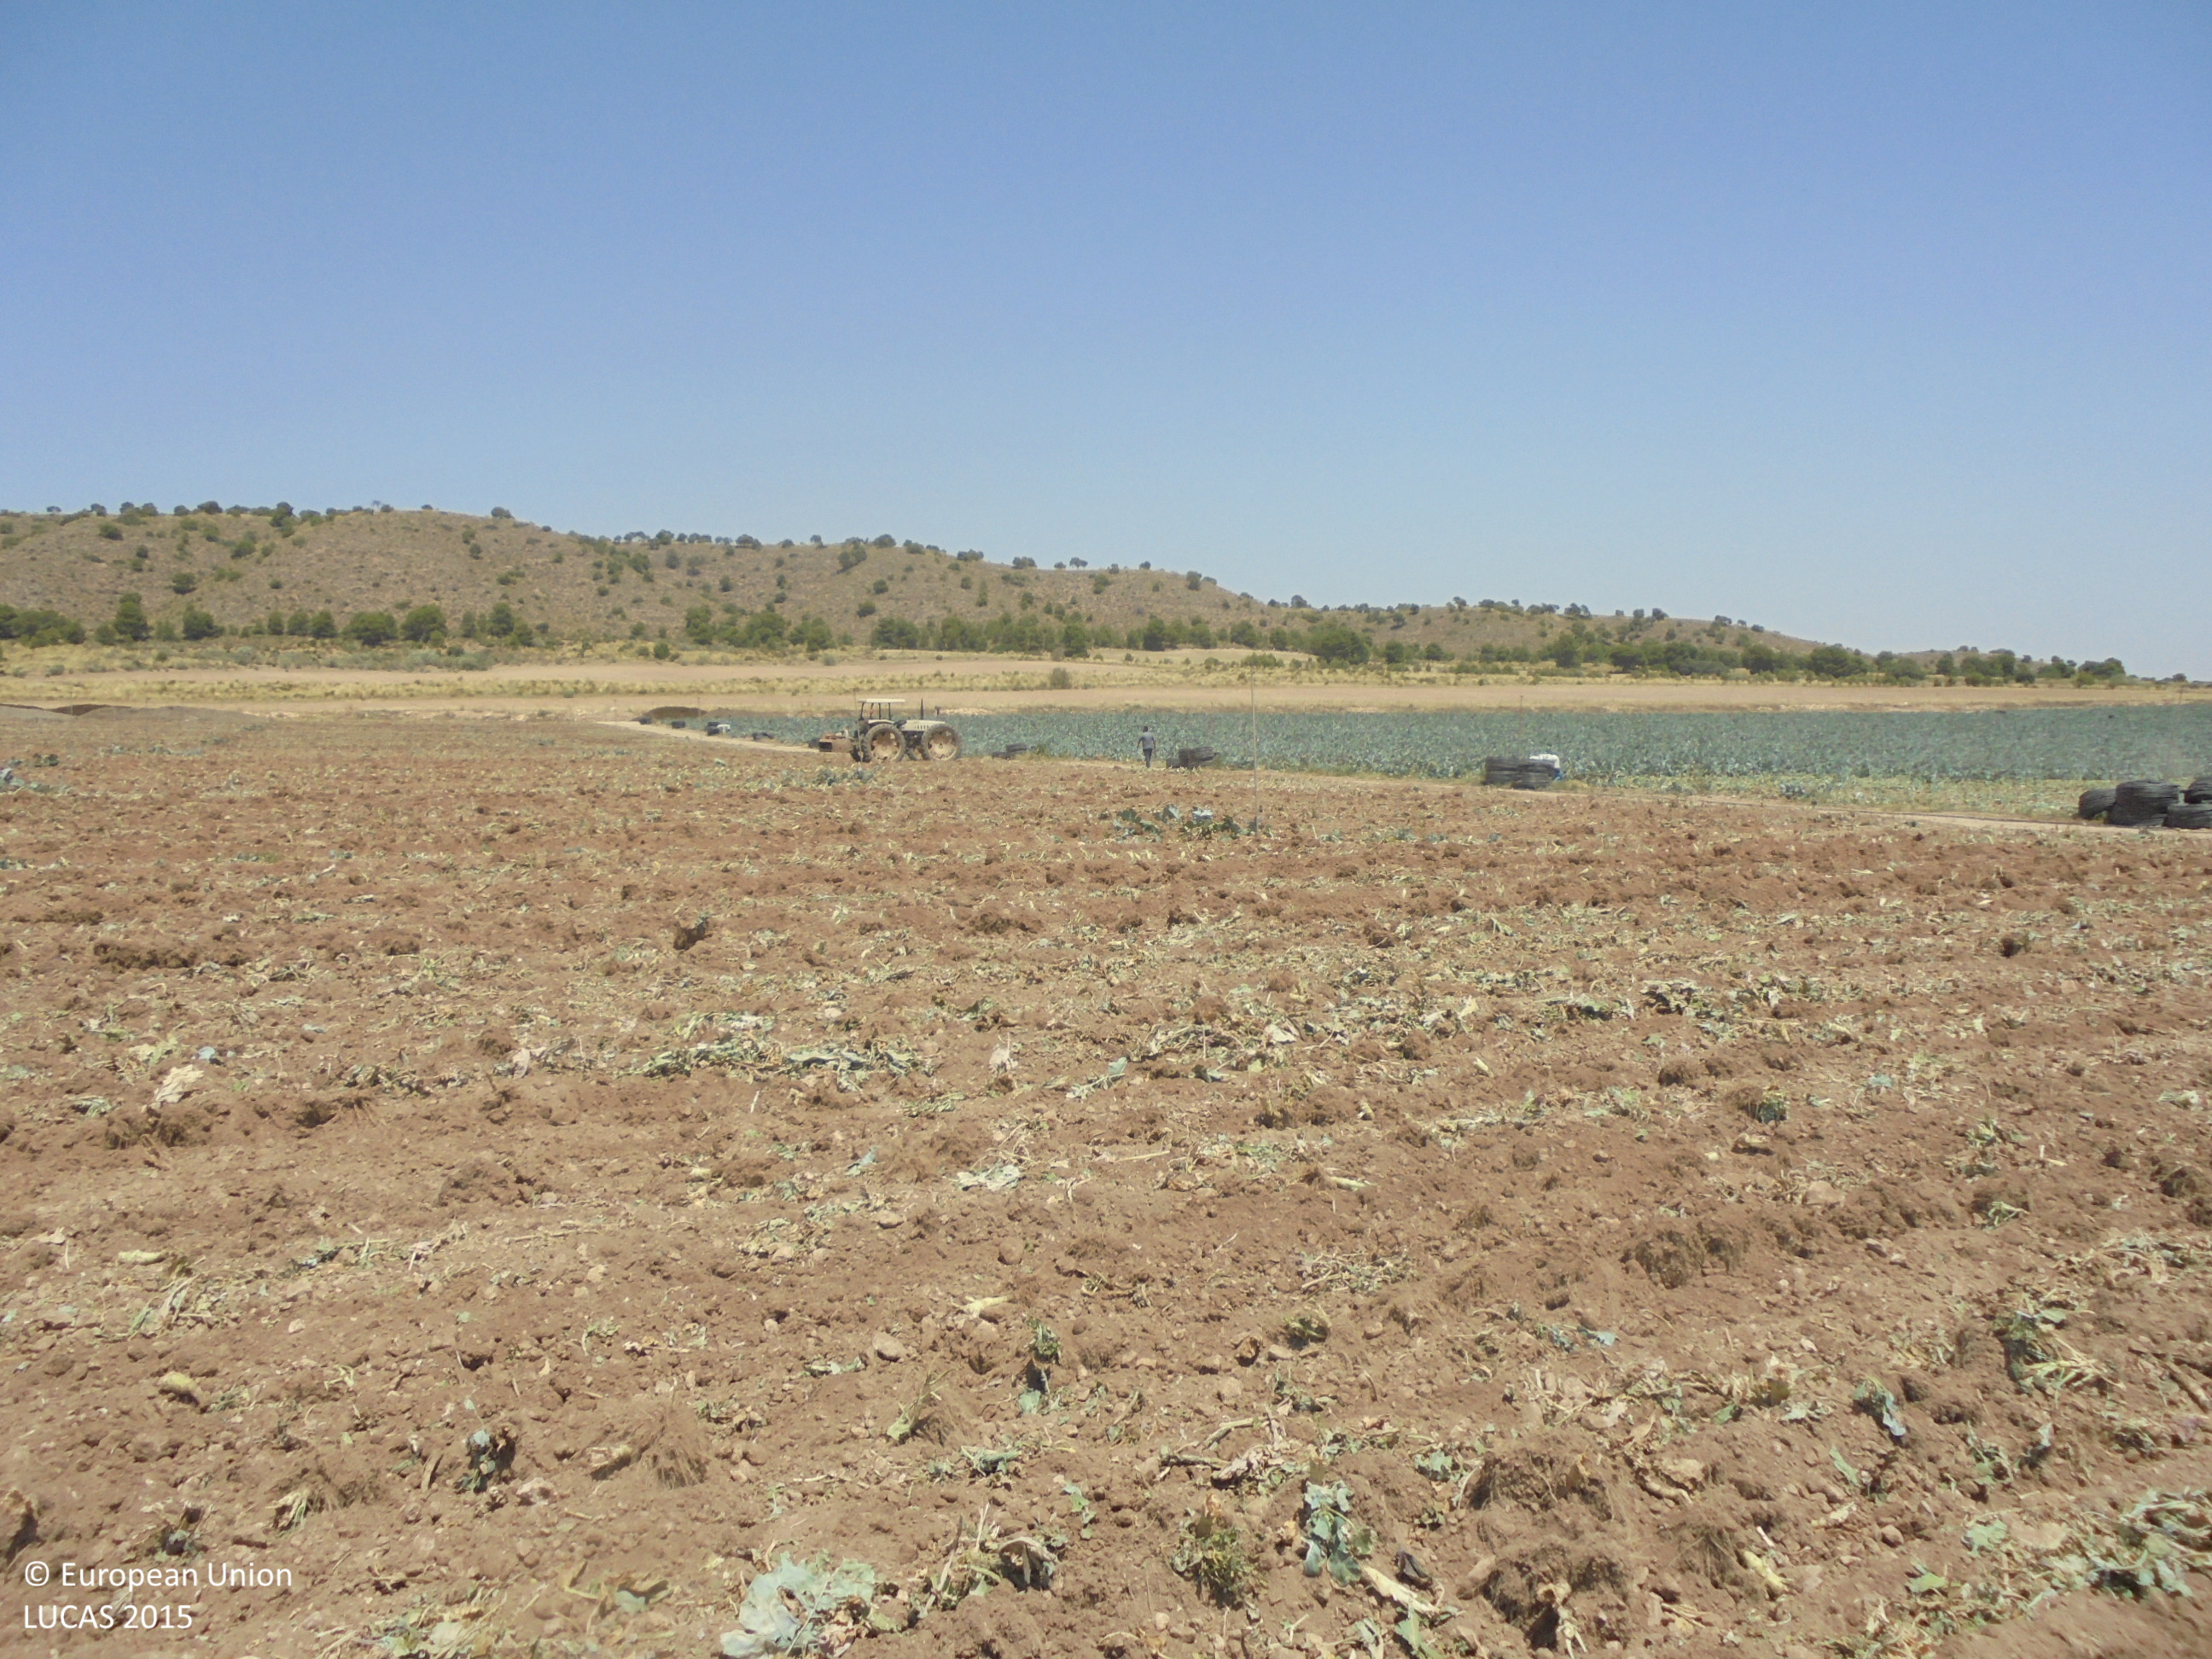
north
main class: Cropland
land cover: Other fresh vegetables
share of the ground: < 10 %
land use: Agriculture (excluding fallow land and kitchen gardens)
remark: Harvested field
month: July
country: ES
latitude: 38.6712
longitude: -1.6843
